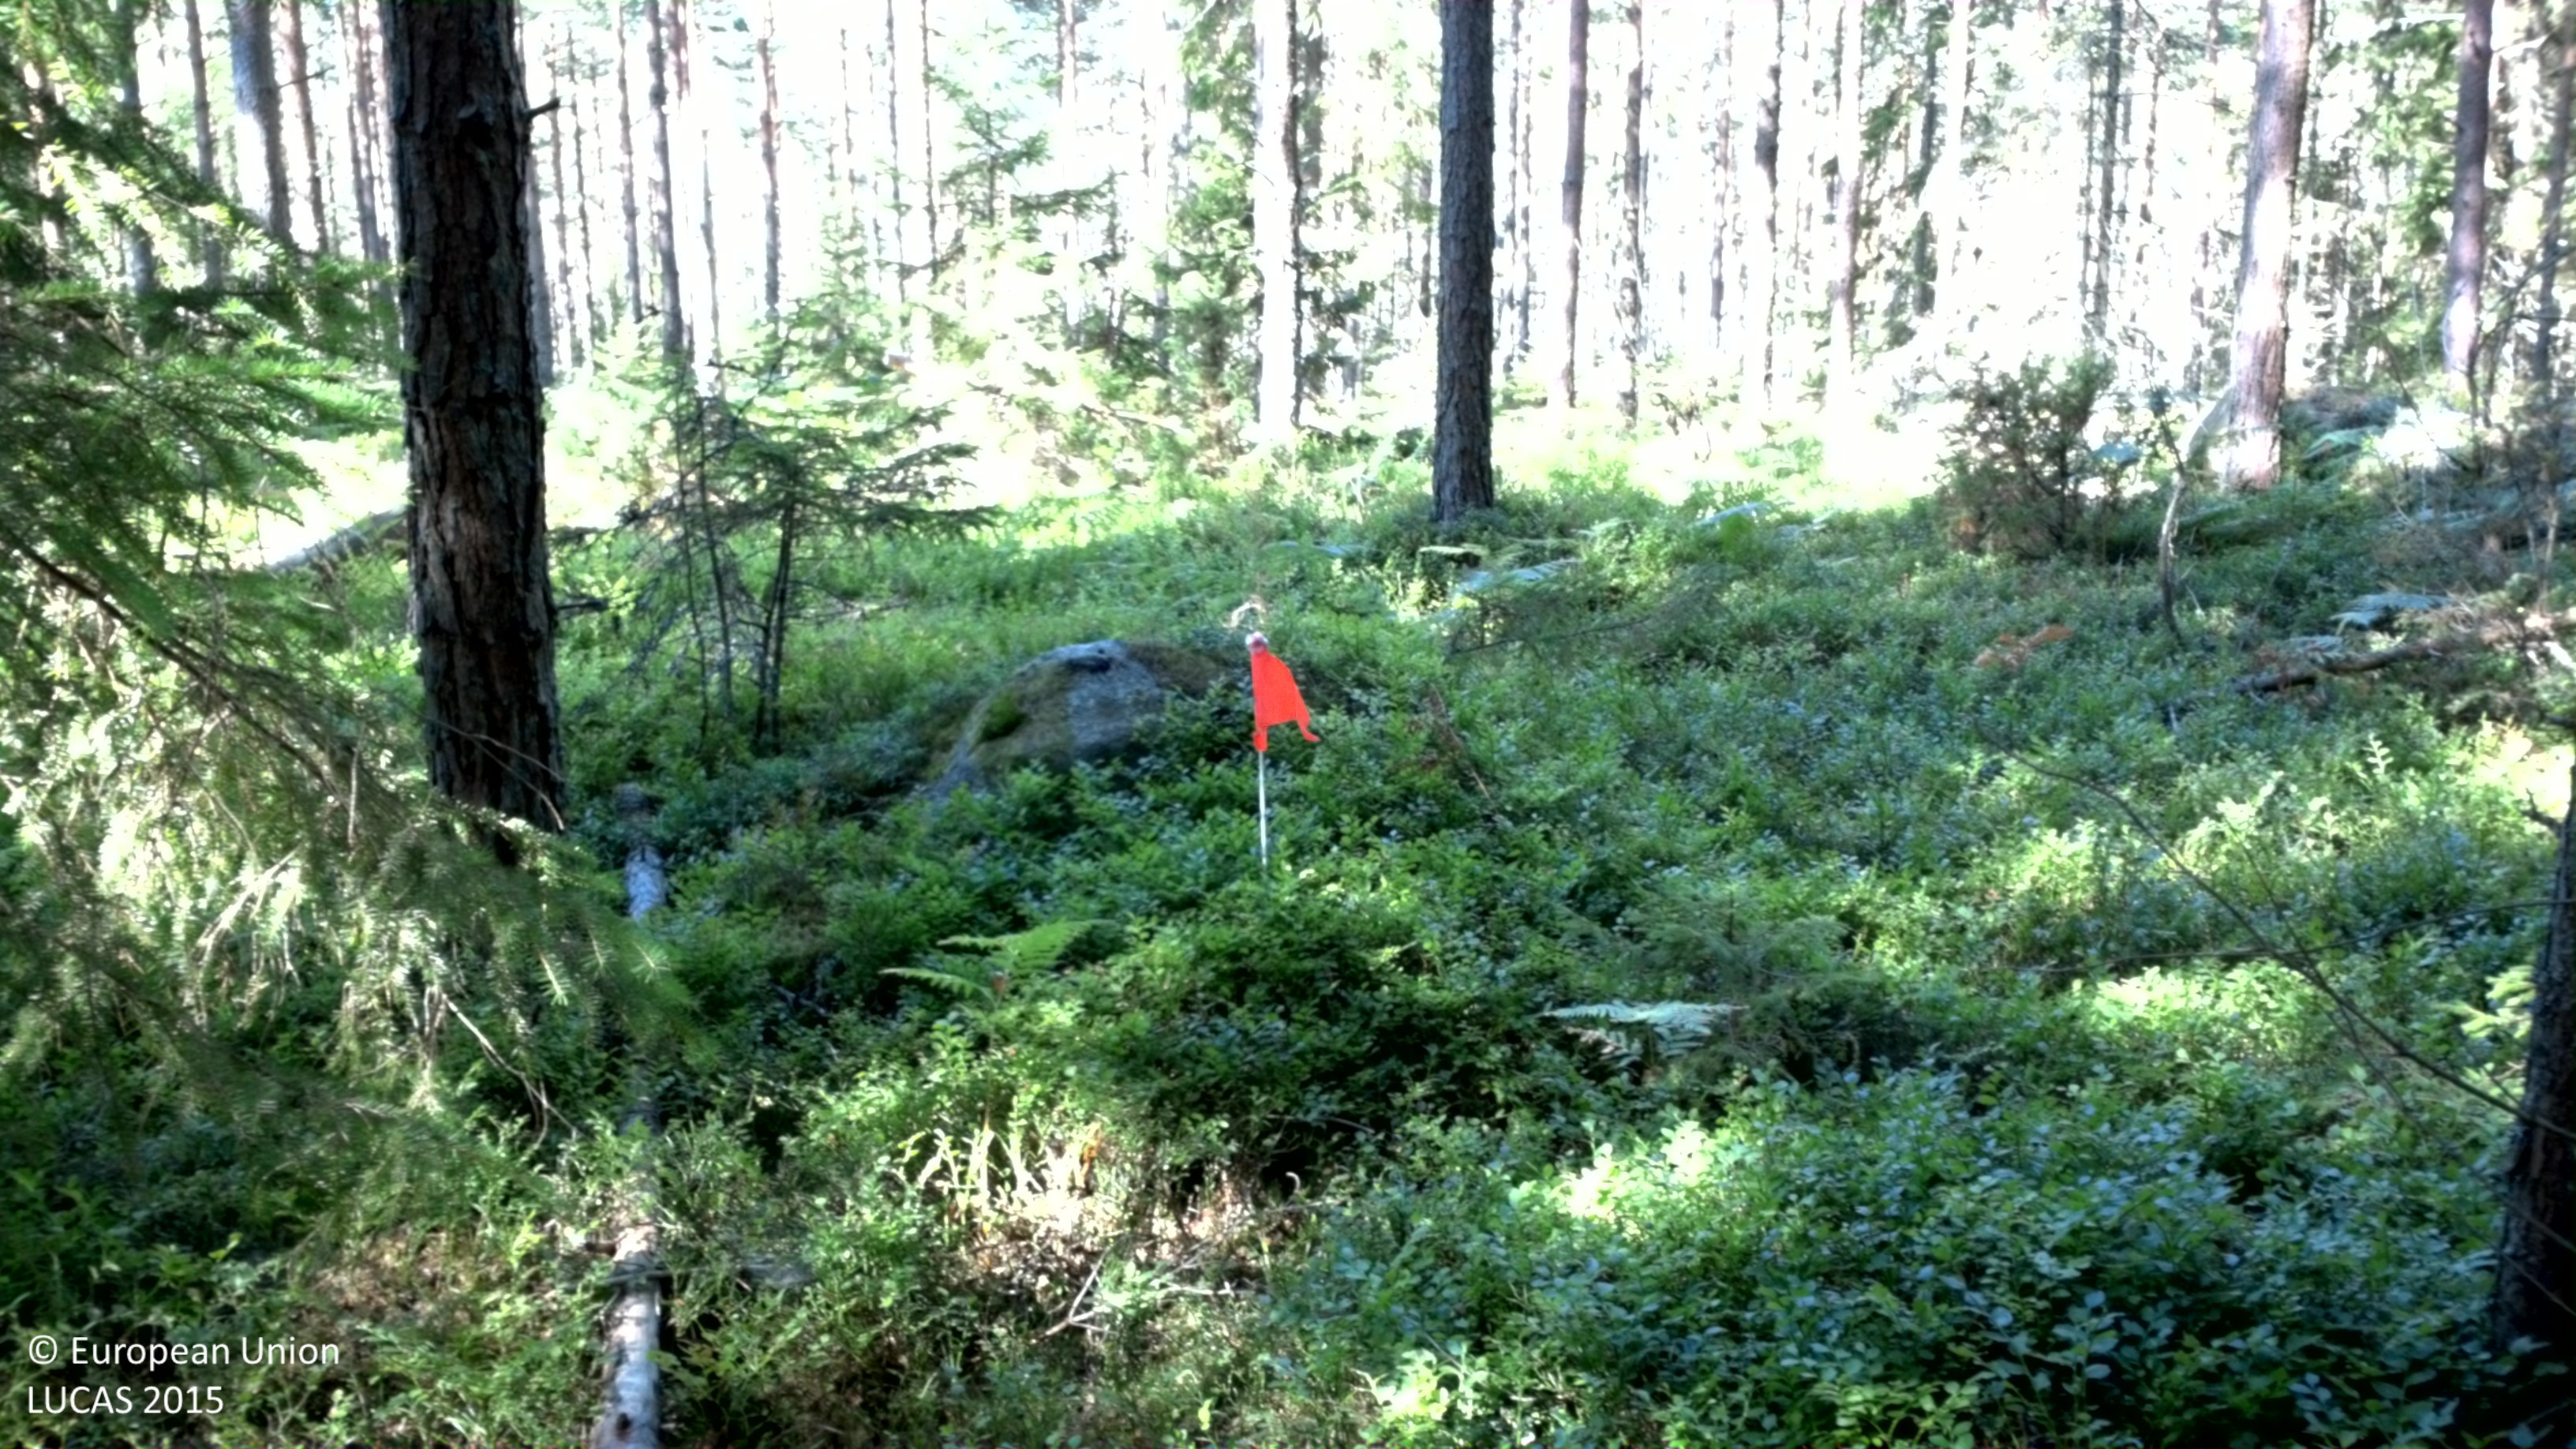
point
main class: Woodland
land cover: Pine dominated coniferous woodland
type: boreal forest
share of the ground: 50 - 75 %
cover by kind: coniferous forest trees 55 %, shrubs 45 %
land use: Forestry
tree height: > 5 m
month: August
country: SE
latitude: 56.3501
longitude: 14.8040
